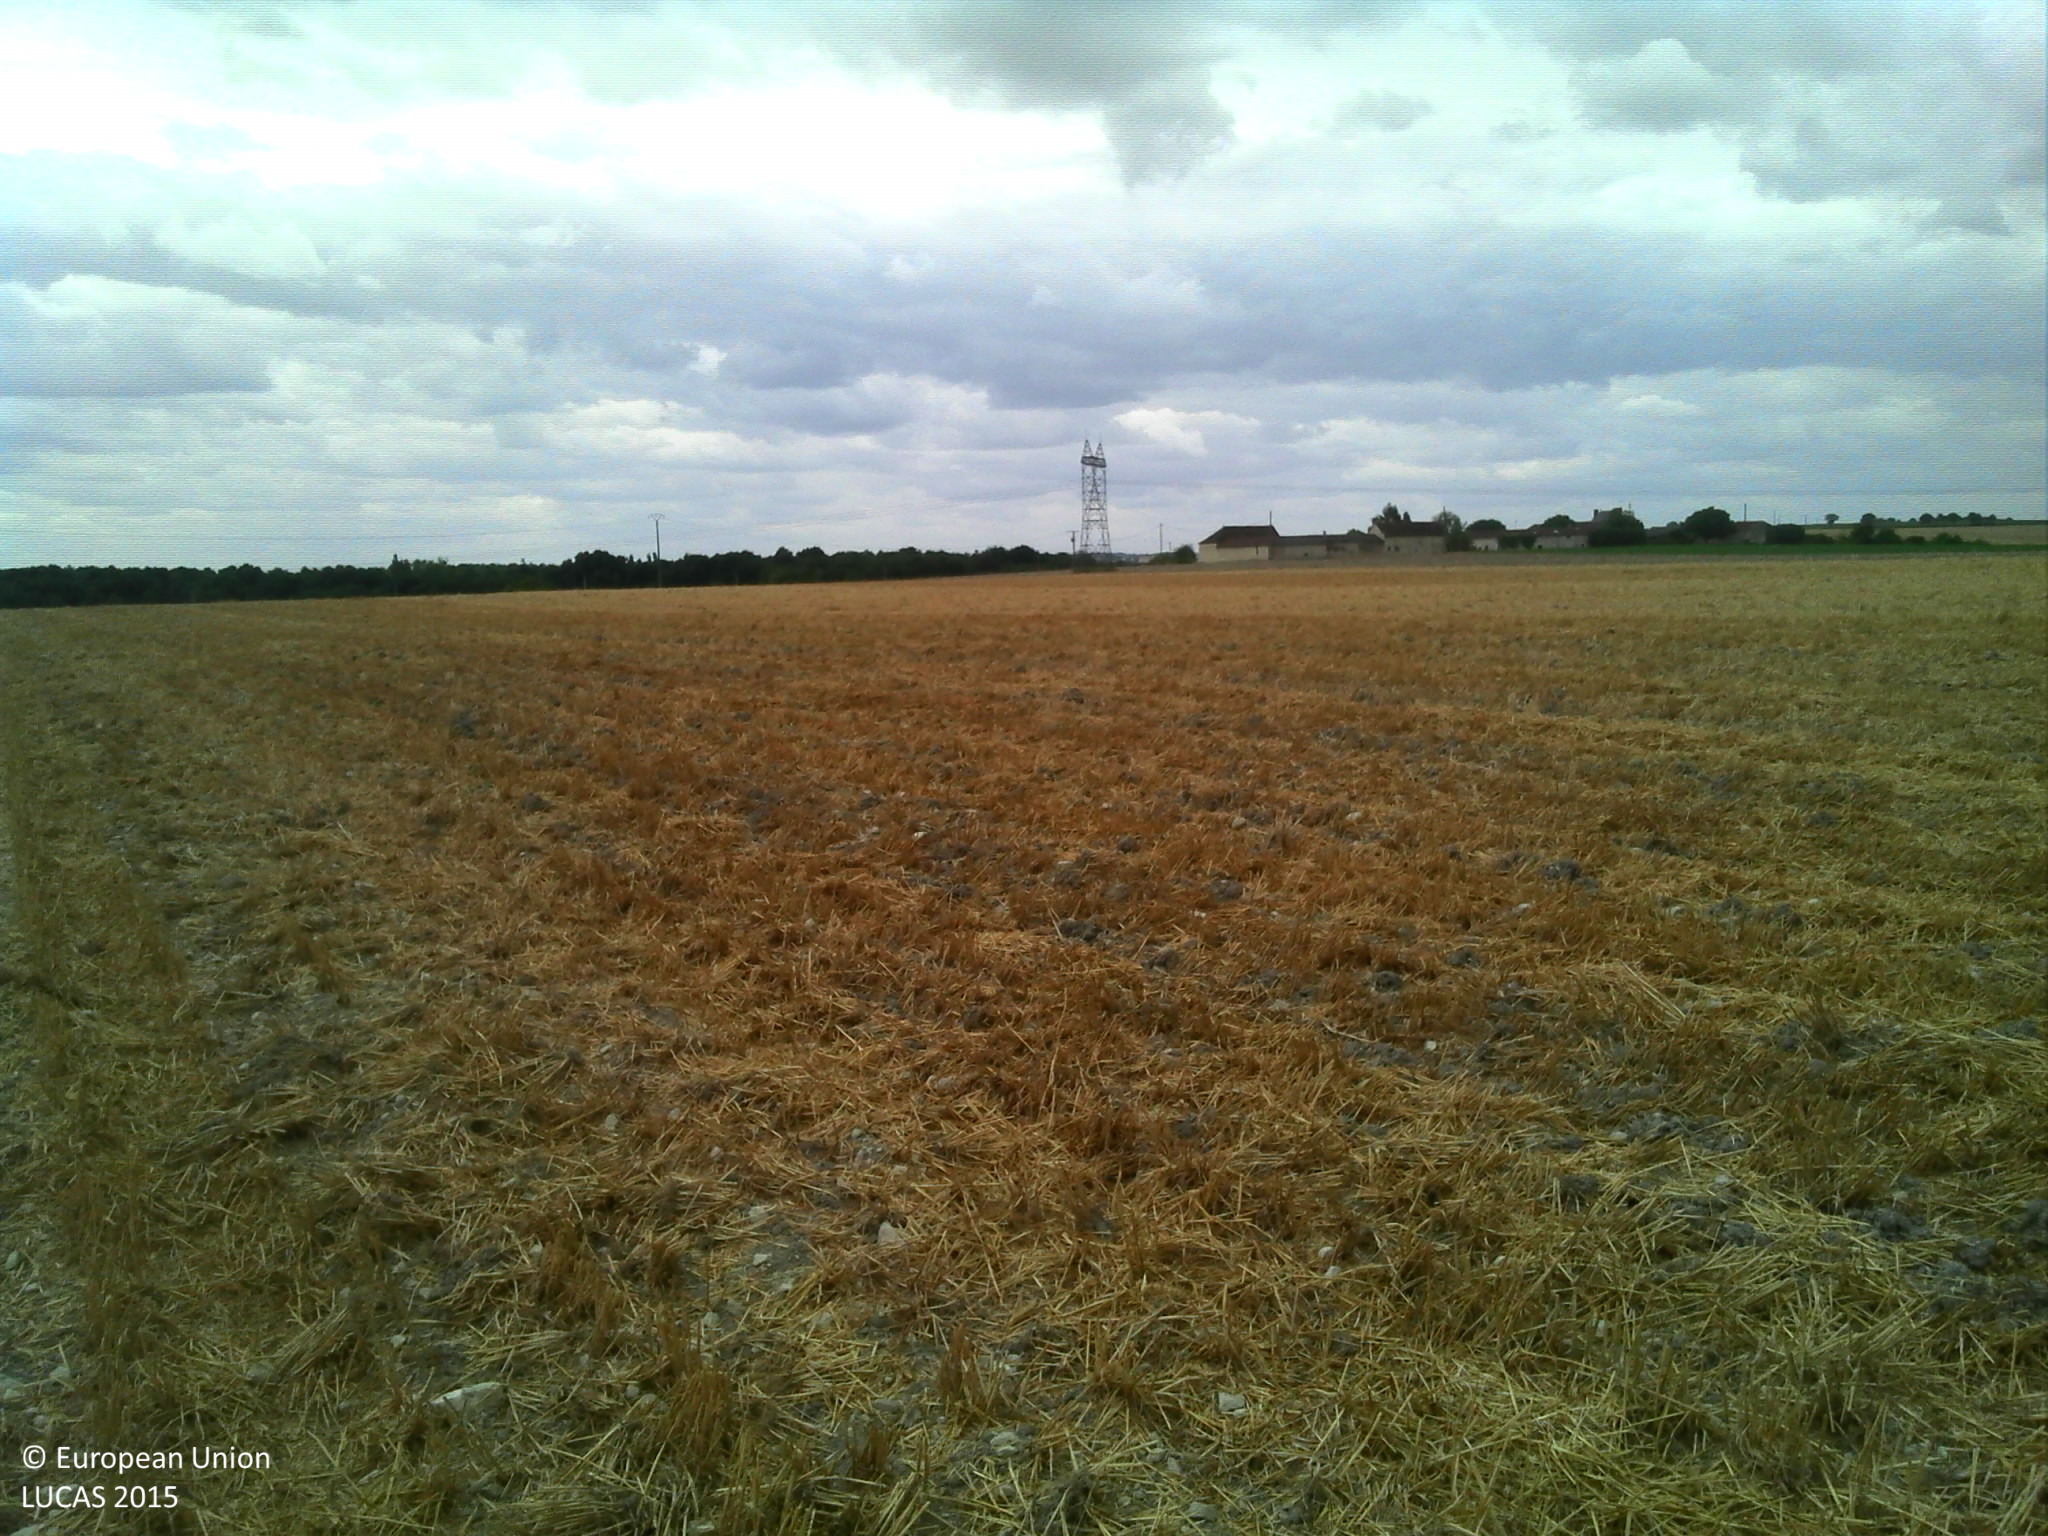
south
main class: Cropland
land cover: Common wheat
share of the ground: > 75 %
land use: Agriculture (excluding fallow land and kitchen gardens)
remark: Harvested field
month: July
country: FR
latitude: 46.9520
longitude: 0.4012
